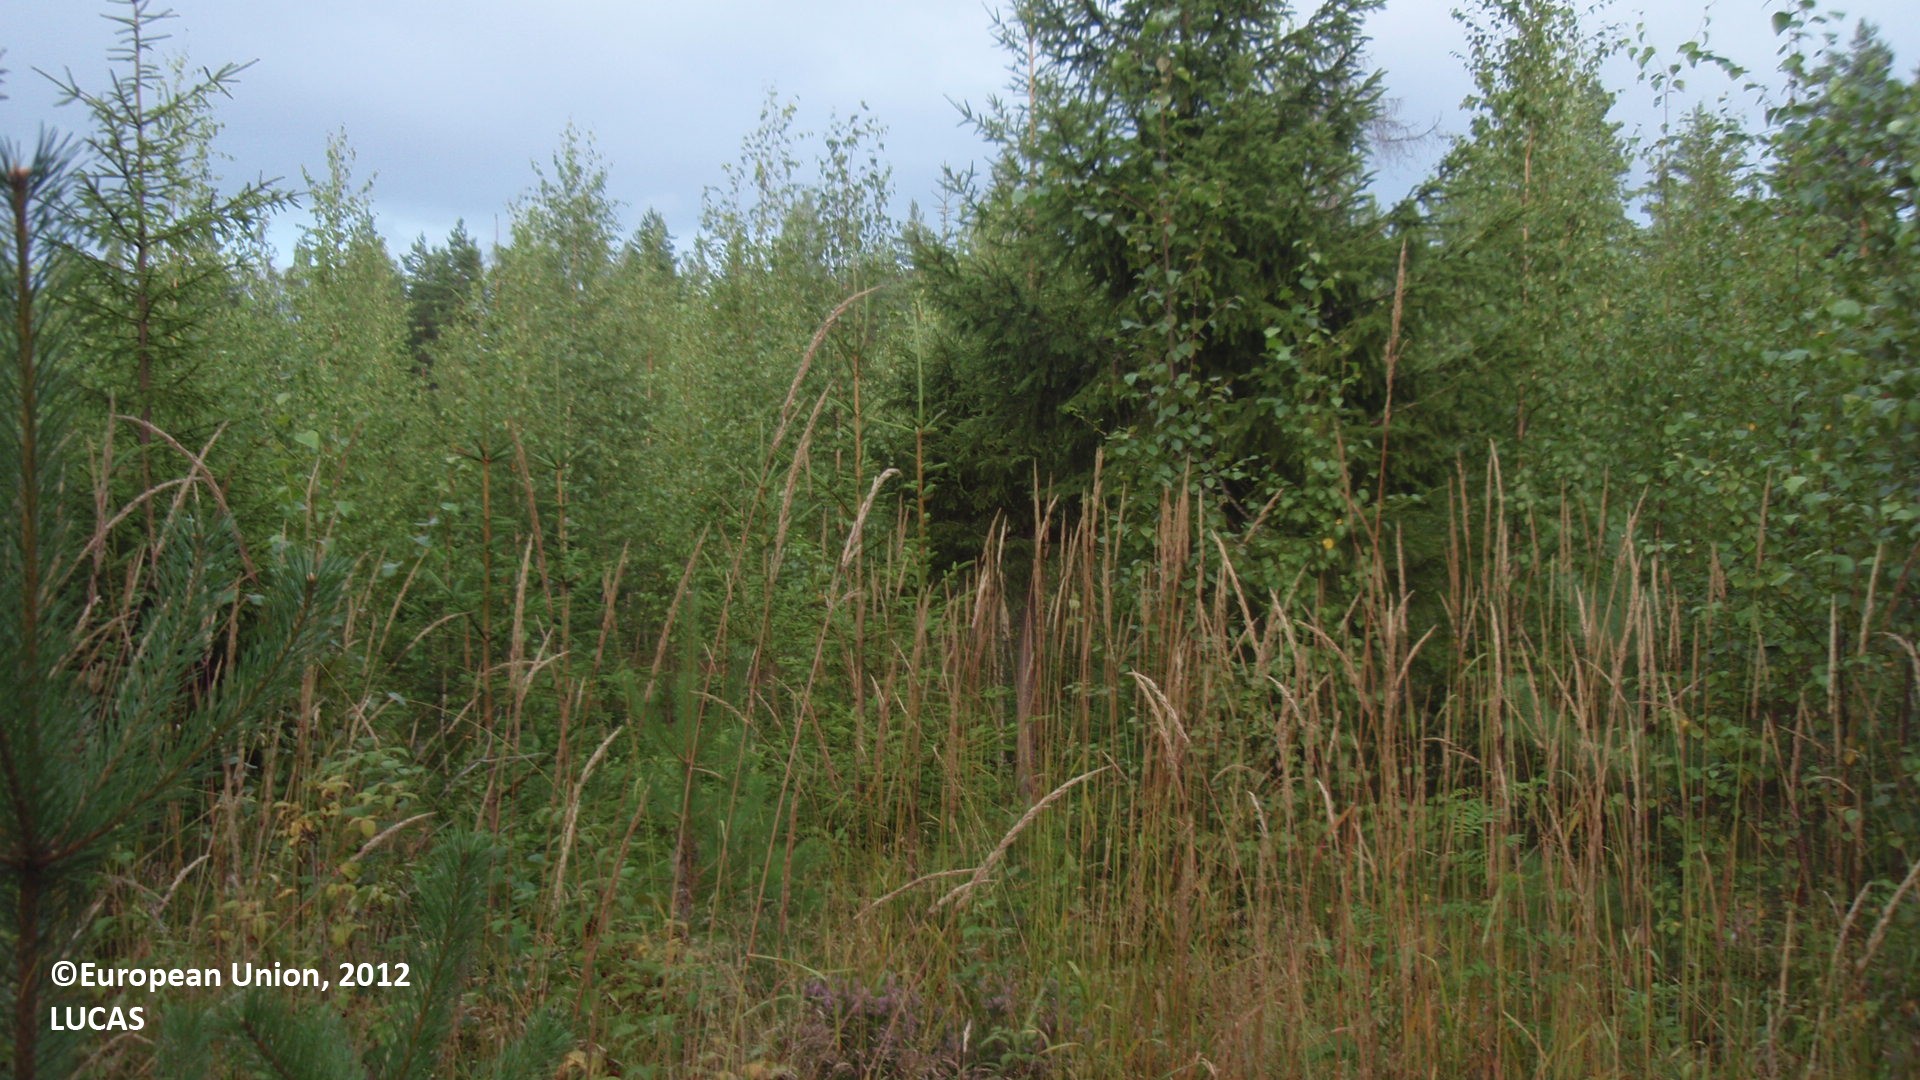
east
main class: Woodland
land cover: Spruce dominated mixed woodland
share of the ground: 50 - 75 %
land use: Forestry
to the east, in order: Spruce dominated mixed woodland; Broadleaved woodland; Pine dominated mixed woodland; Shrubland with sparse tree cover; Pine dominated mixed woodland
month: August
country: FI
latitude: 60.9978
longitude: 27.6601
